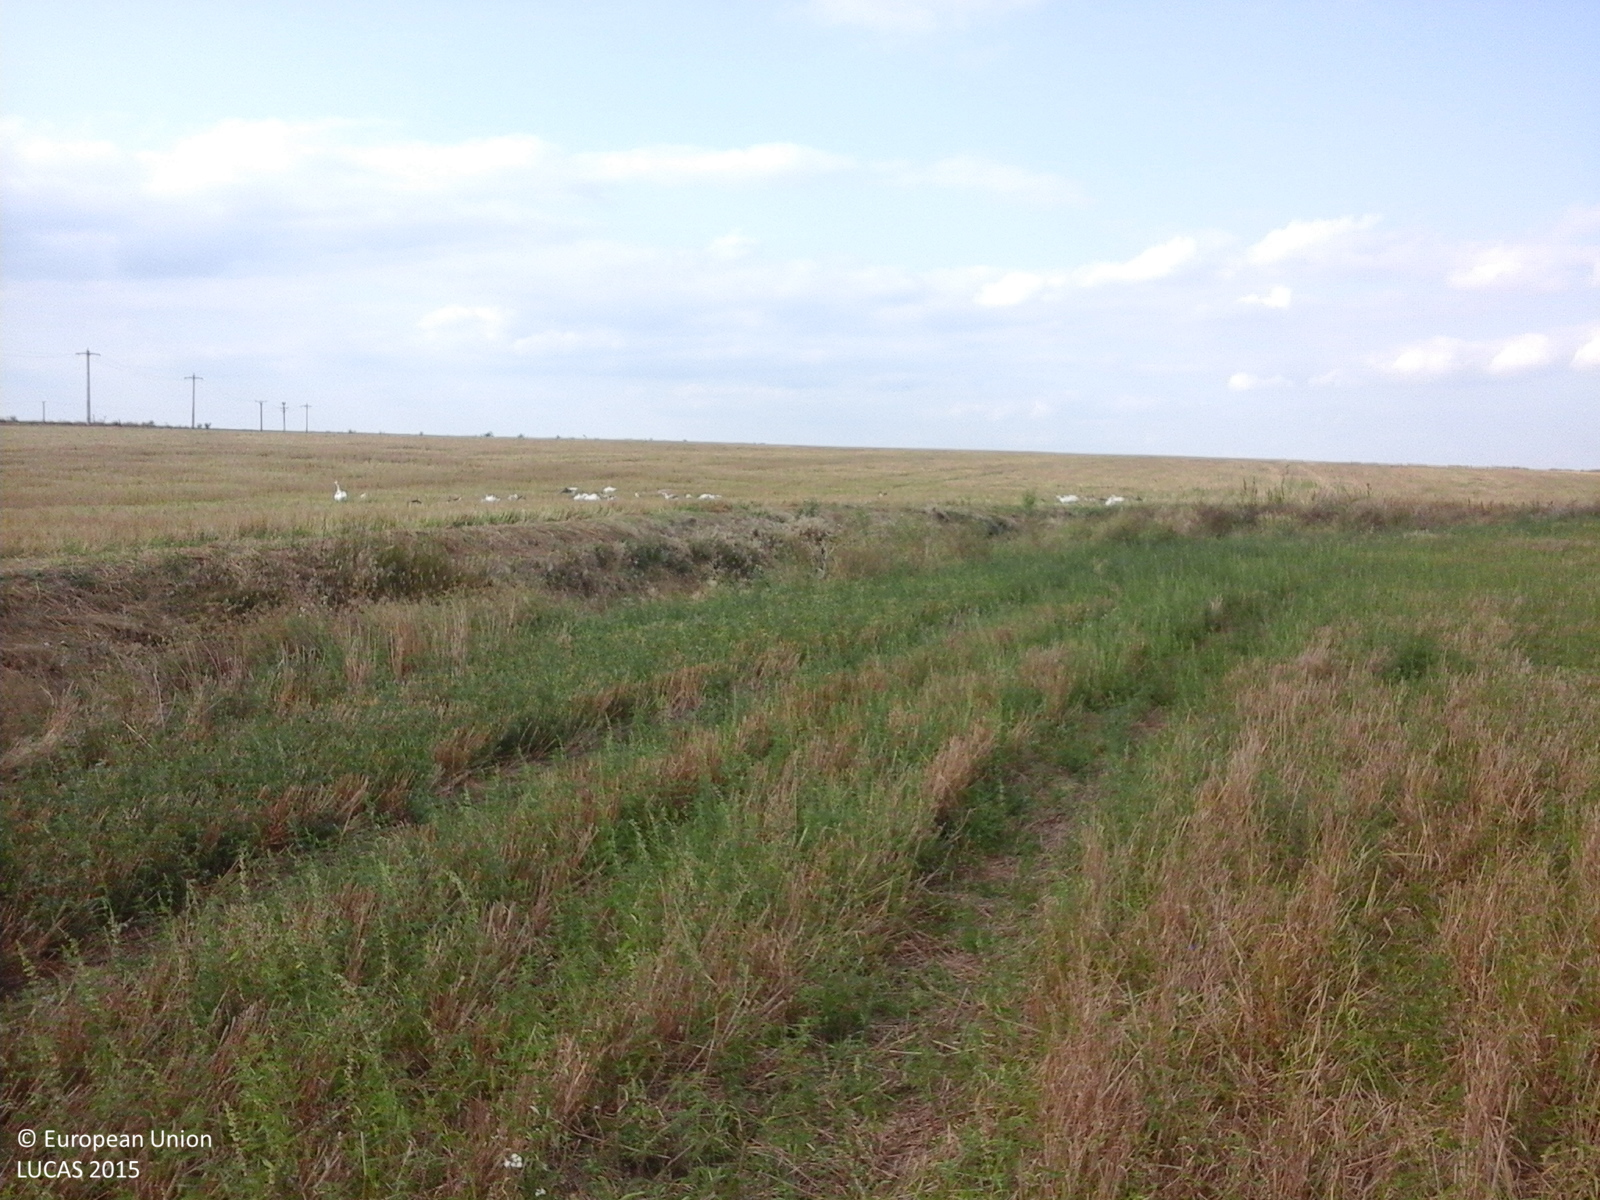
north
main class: Cropland
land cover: Triticale
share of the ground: > 75 %
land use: Agriculture (excluding fallow land and kitchen gardens)
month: August
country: RO
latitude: 44.6503
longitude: 28.4709
